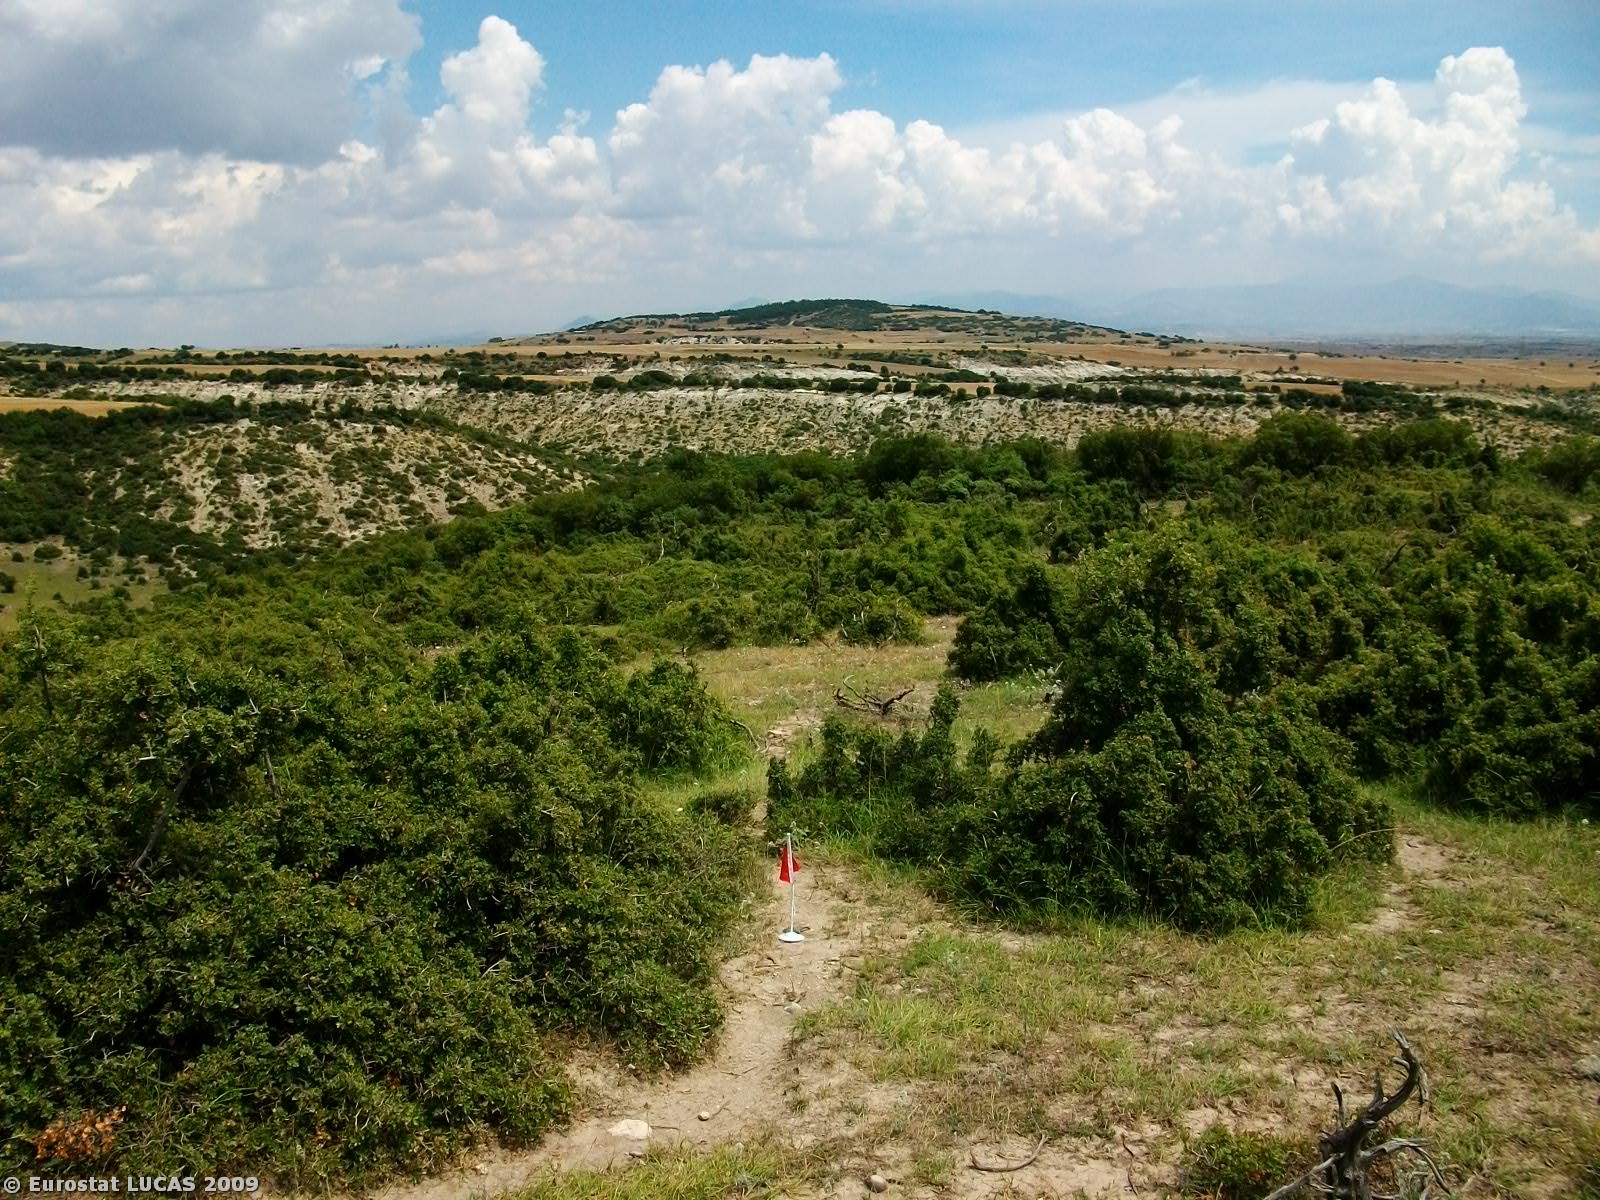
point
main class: Shrubland
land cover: Shrubland without tree cover
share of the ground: > 75 %
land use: Unused
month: July
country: GR
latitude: 40.1360
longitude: 21.8090
